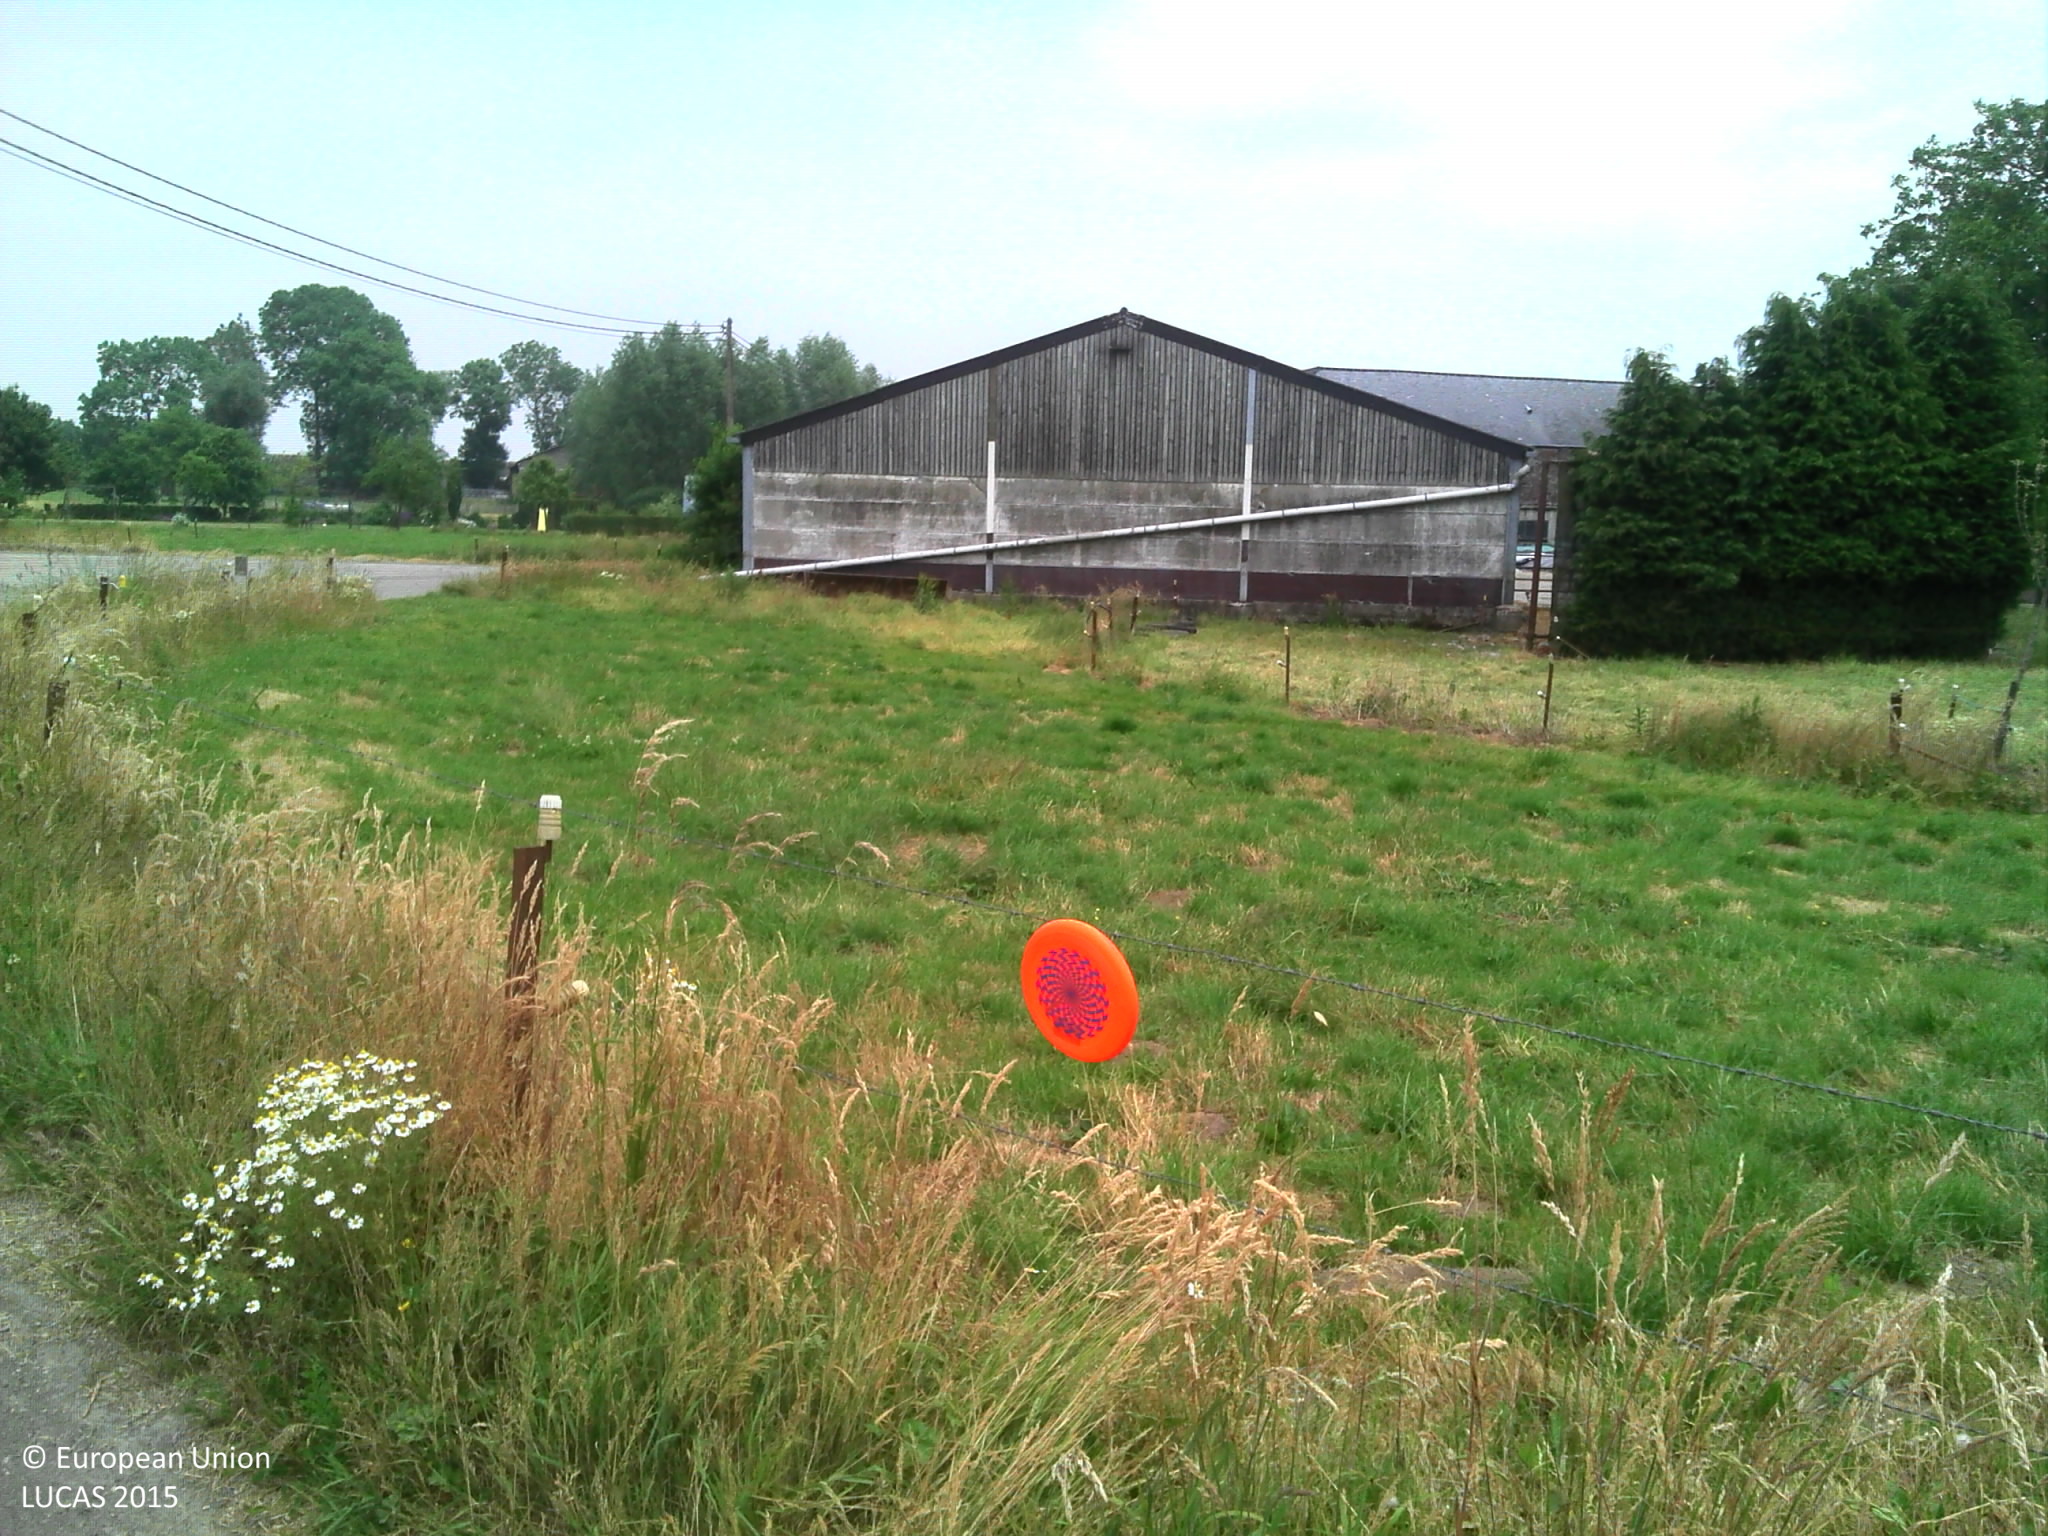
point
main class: Grassland
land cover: Grassland without tree/shrub cover
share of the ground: > 75 %
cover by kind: herbaceous plants 100 %
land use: Agriculture (excluding fallow land and kitchen gardens)
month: June
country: BE
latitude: 50.3841
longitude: 5.5119
